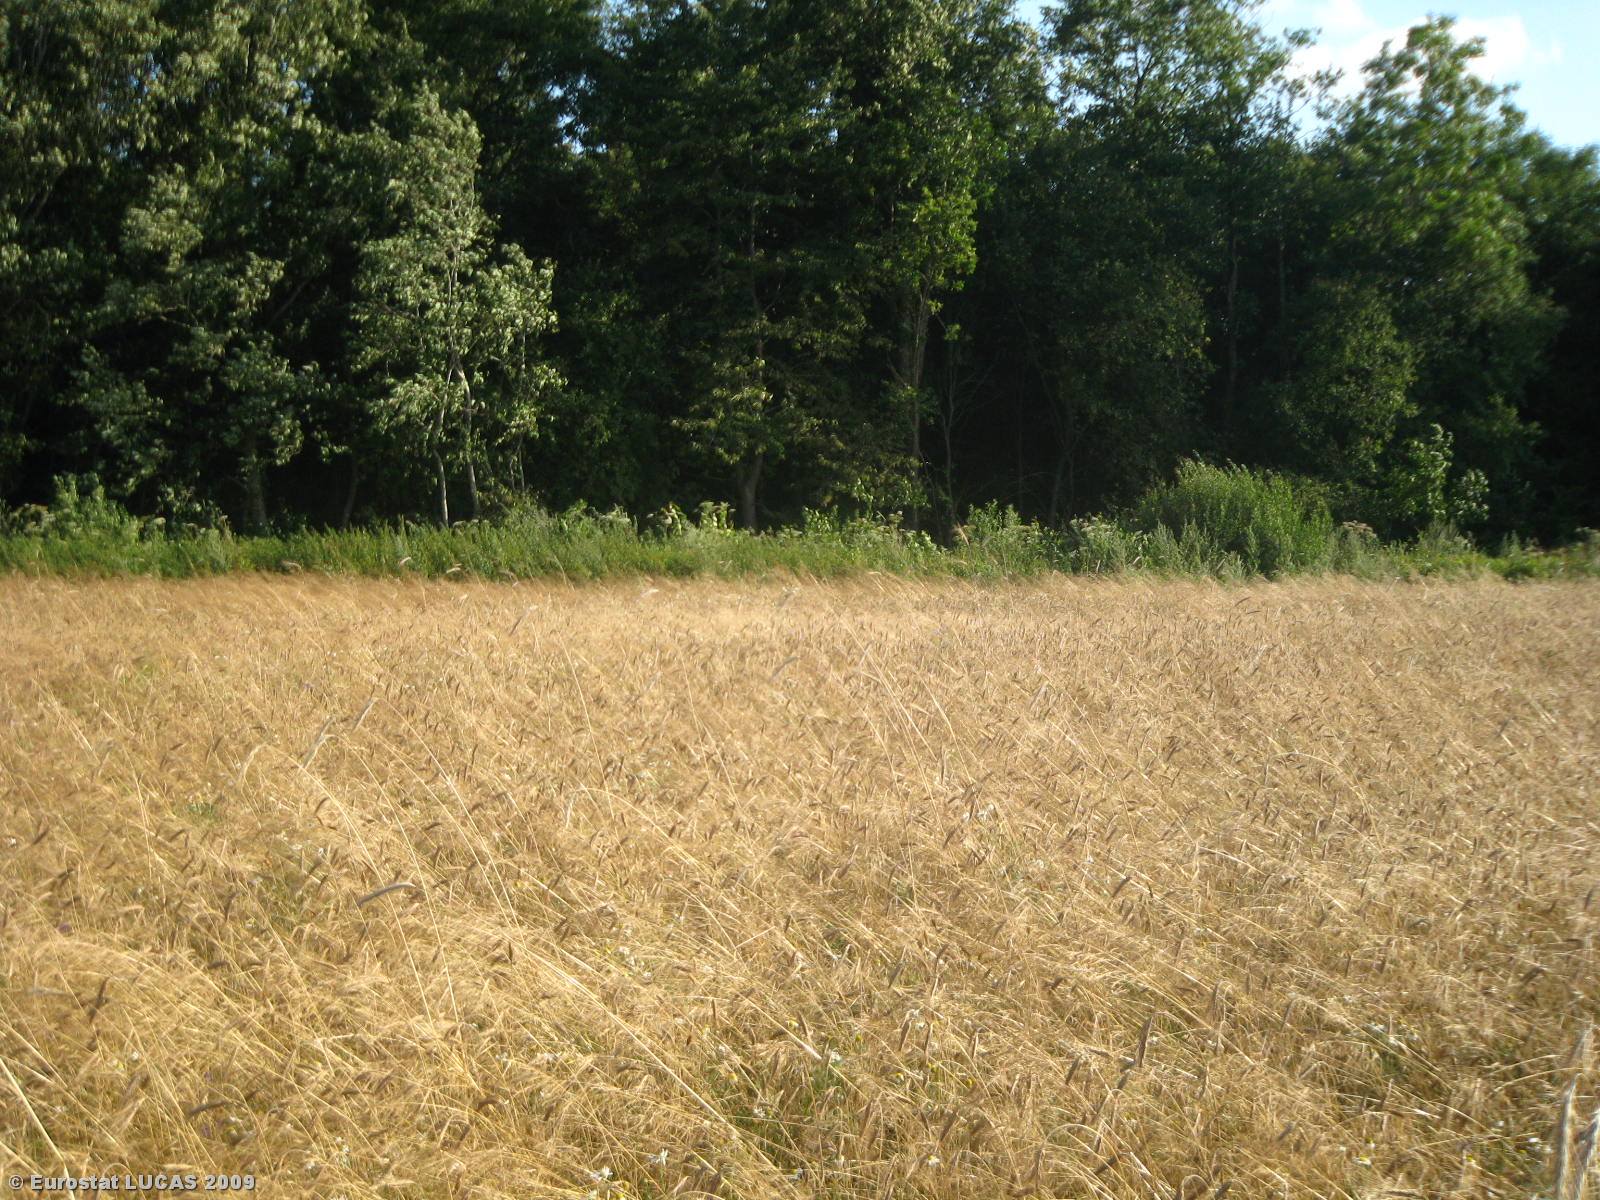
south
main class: Cropland
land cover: Rye
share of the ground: > 75 %
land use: Agriculture (excluding fallow land and kitchen gardens)
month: July
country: LT
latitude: 55.1495
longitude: 23.5923
